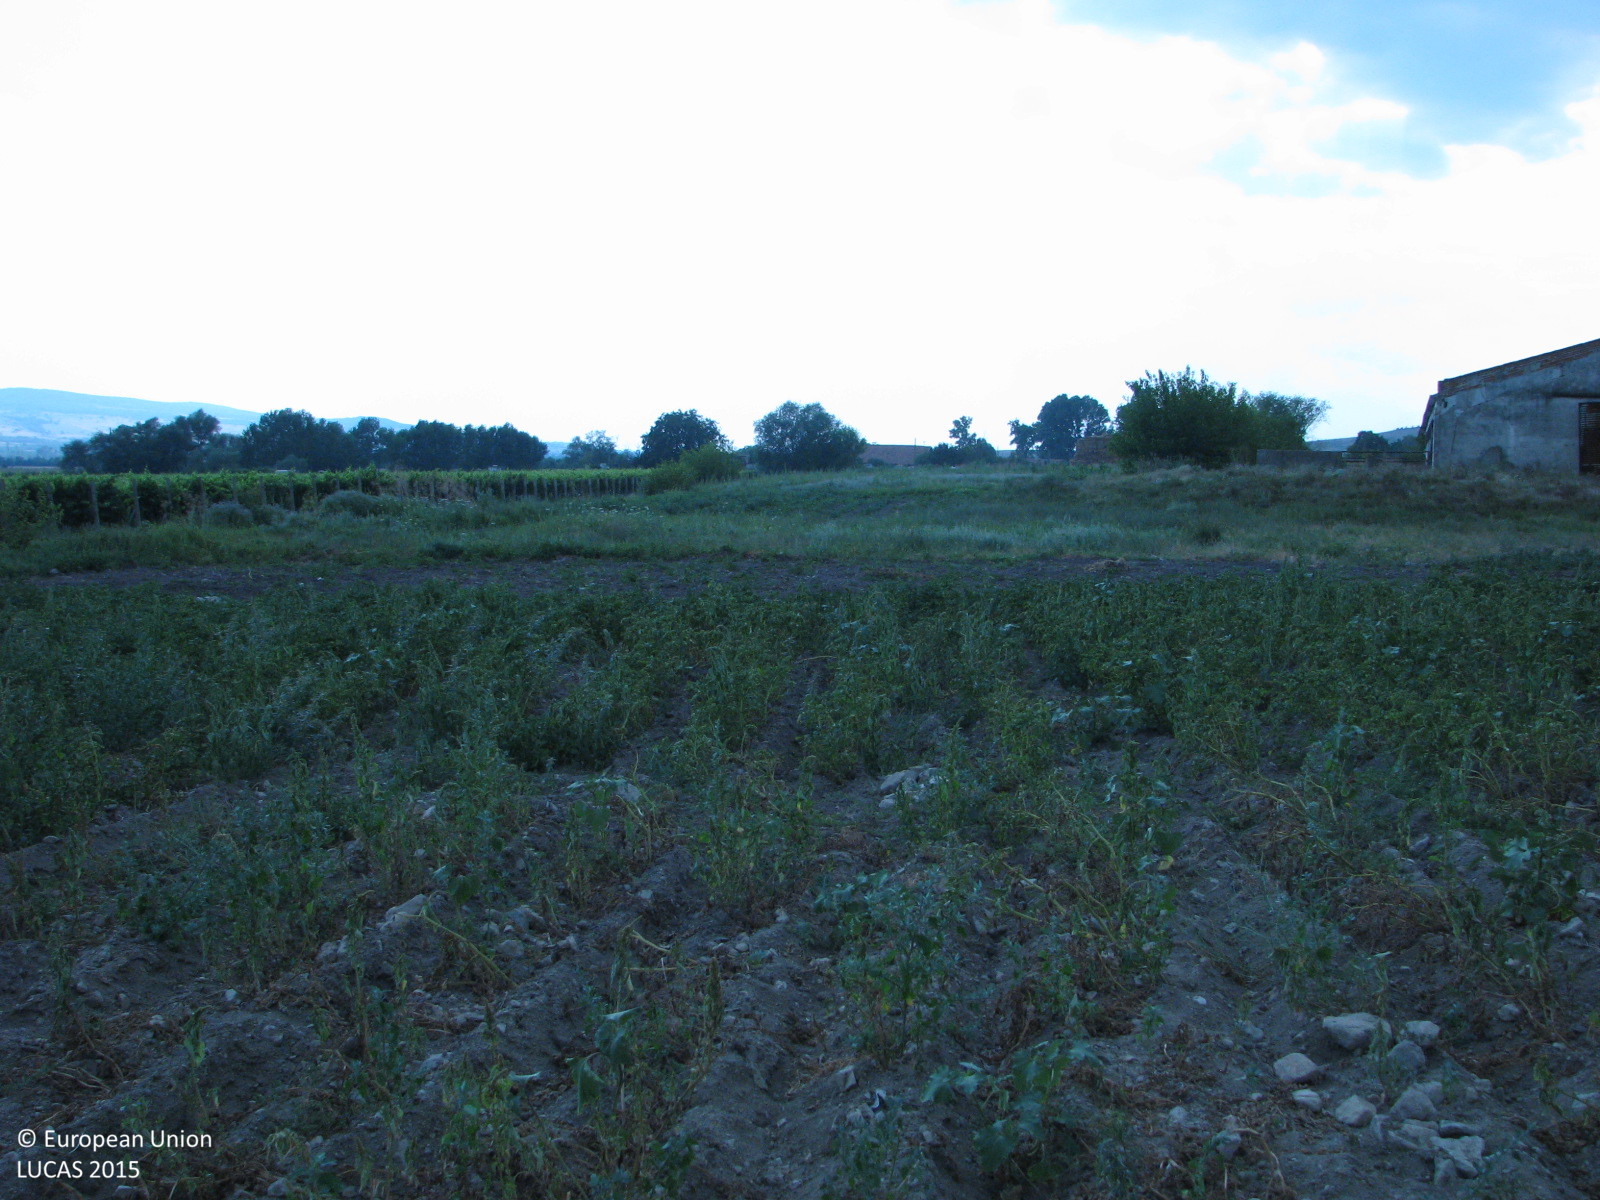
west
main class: Cropland
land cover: Potatoes
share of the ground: 25 - 50 %
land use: Agriculture (excluding fallow land and kitchen gardens)
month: July
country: BG
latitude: 42.6795
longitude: 25.9838
